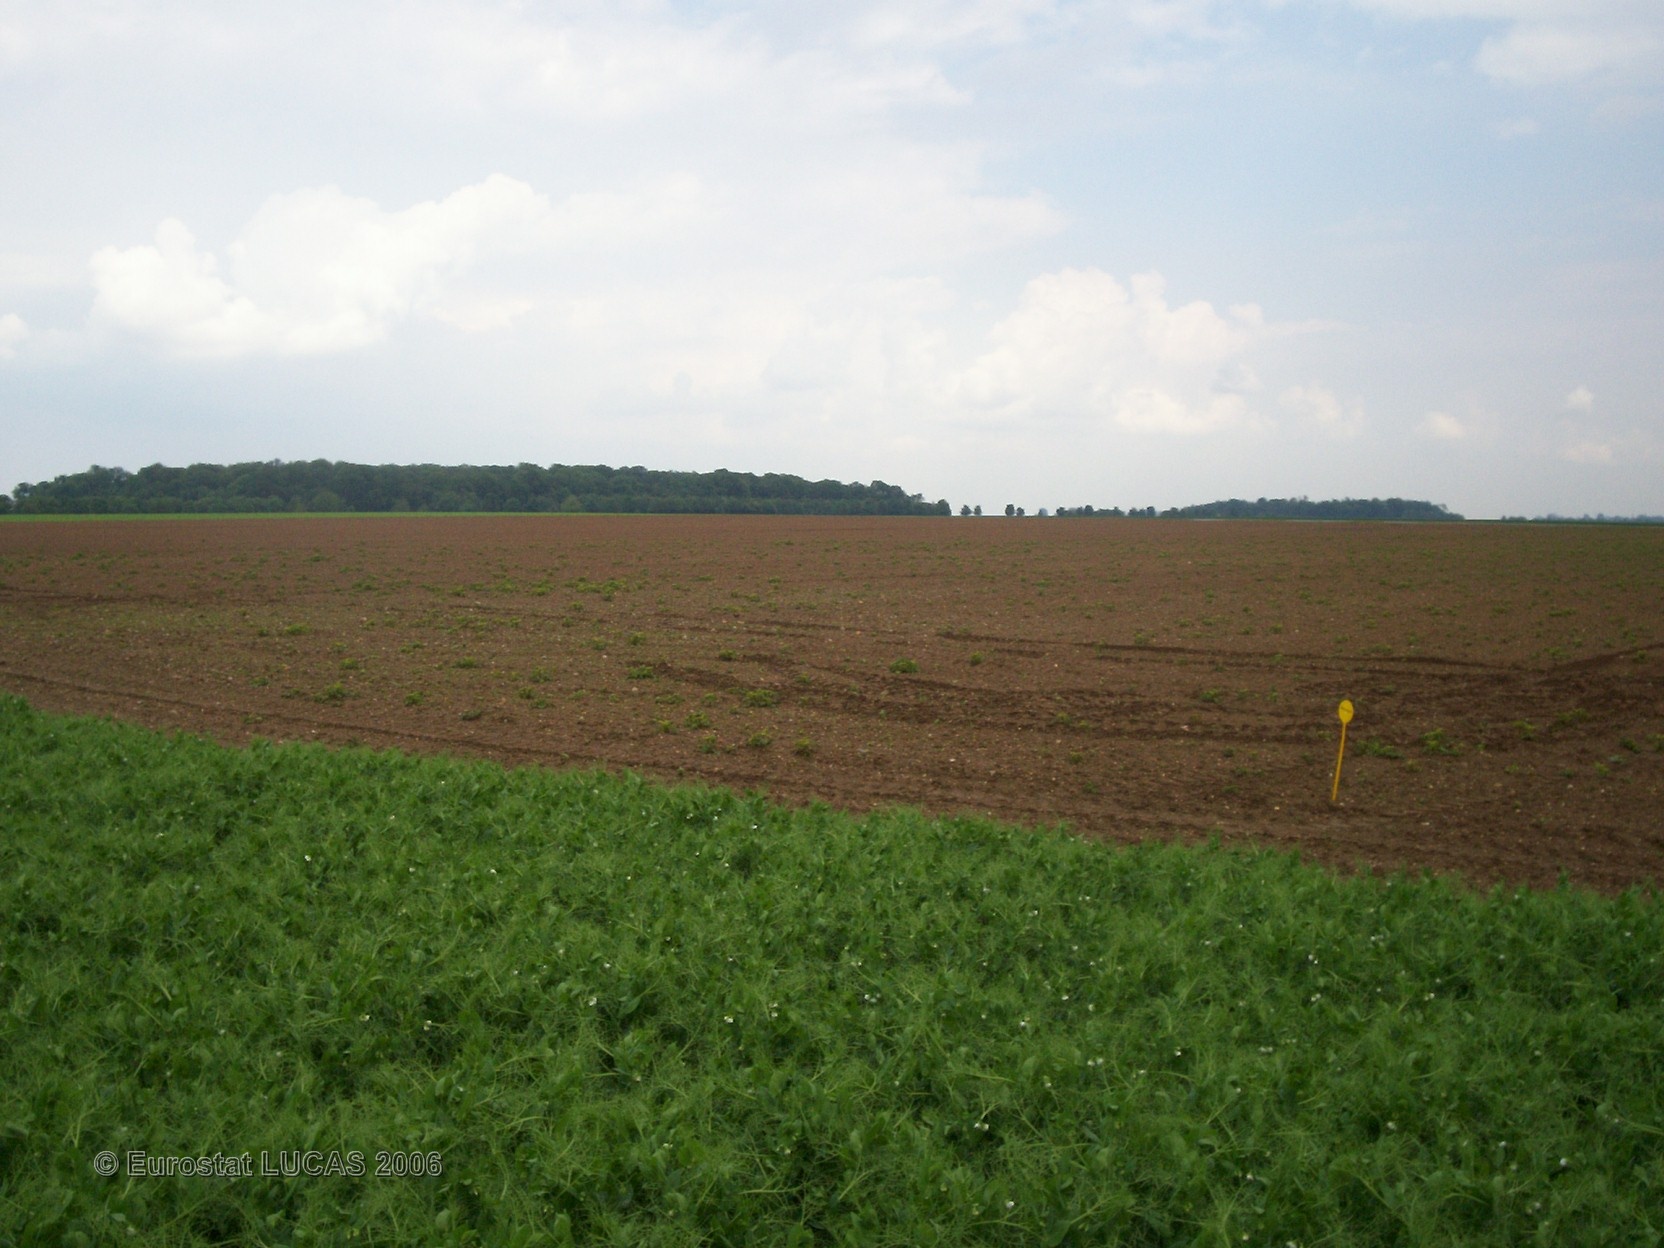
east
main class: Cropland
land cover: Dry pulses
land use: Agriculture (excluding fallow land and kitchen gardens)
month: June
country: FR
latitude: 49.7641
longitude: 2.6165
